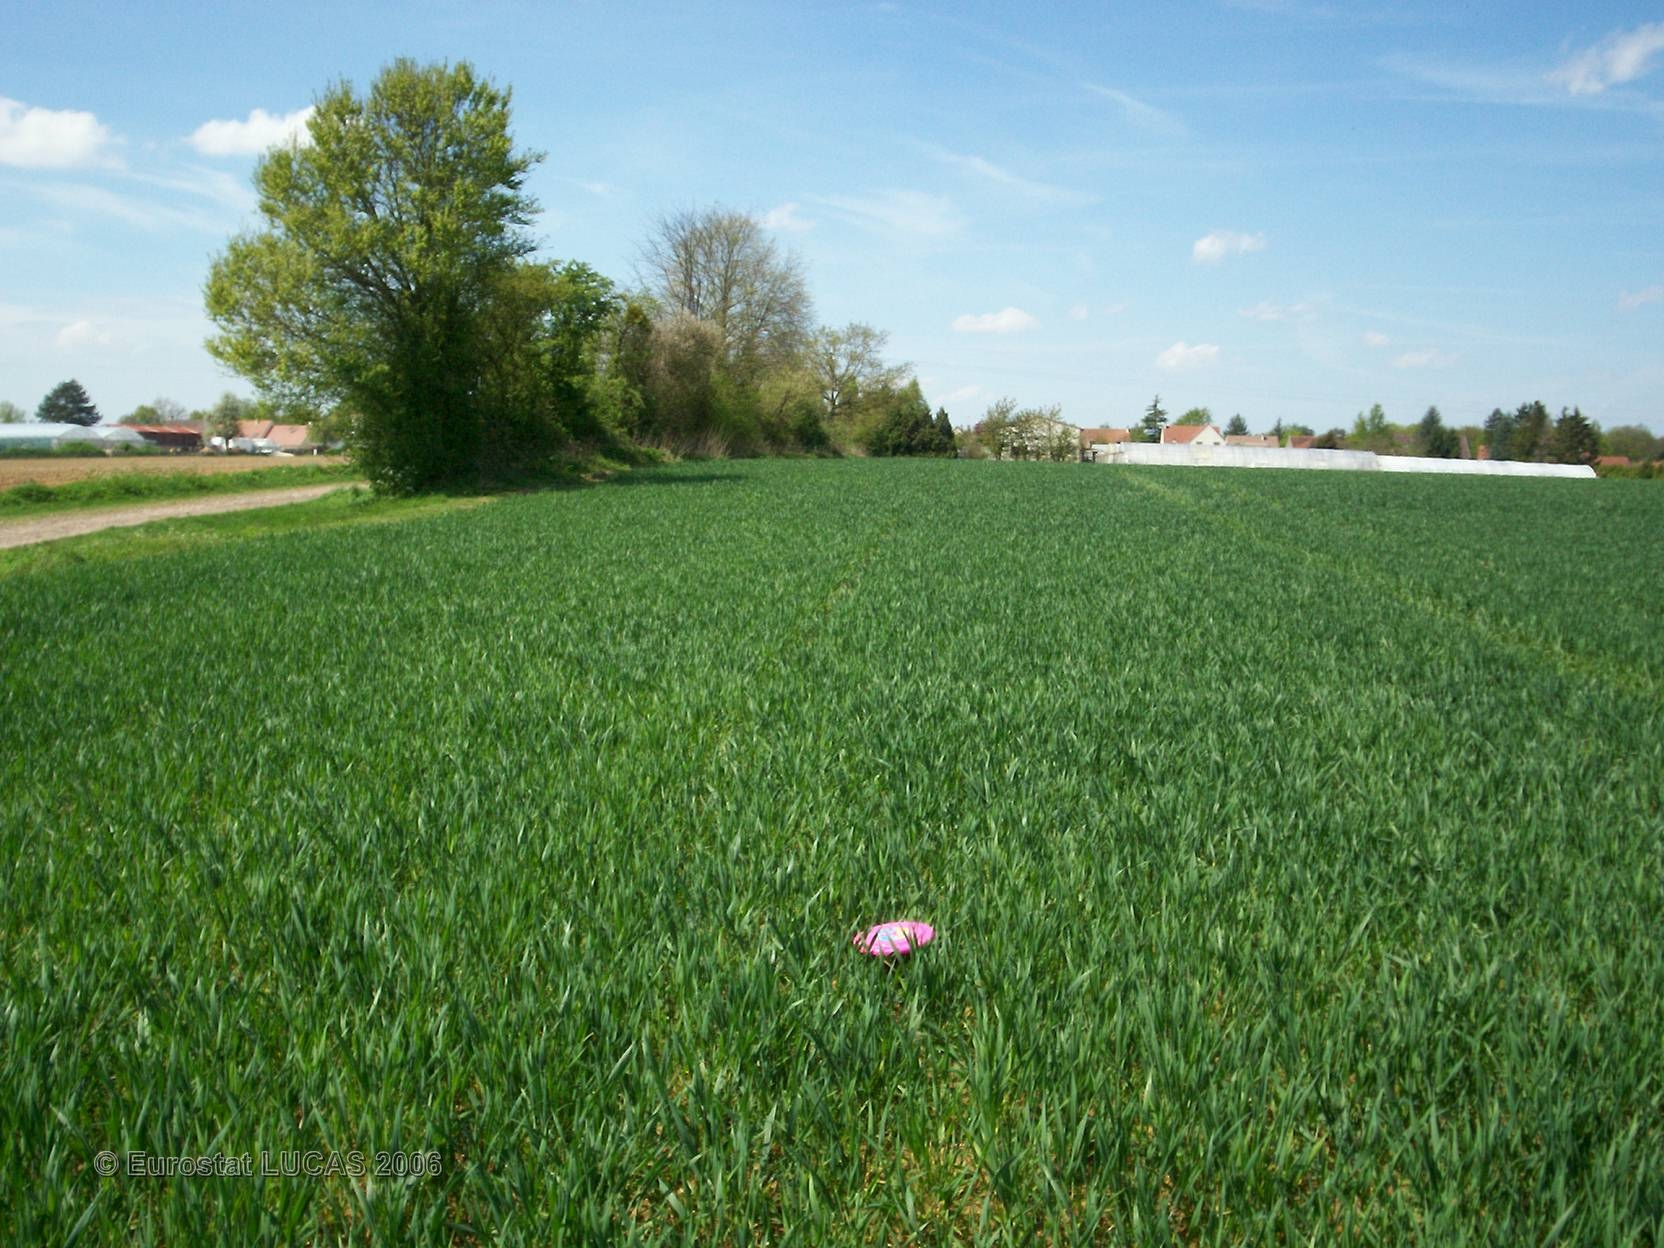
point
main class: Cropland
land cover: Common wheat
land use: Agriculture (excluding fallow land and kitchen gardens)
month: May
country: FR
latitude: 48.8001
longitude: 2.7884
